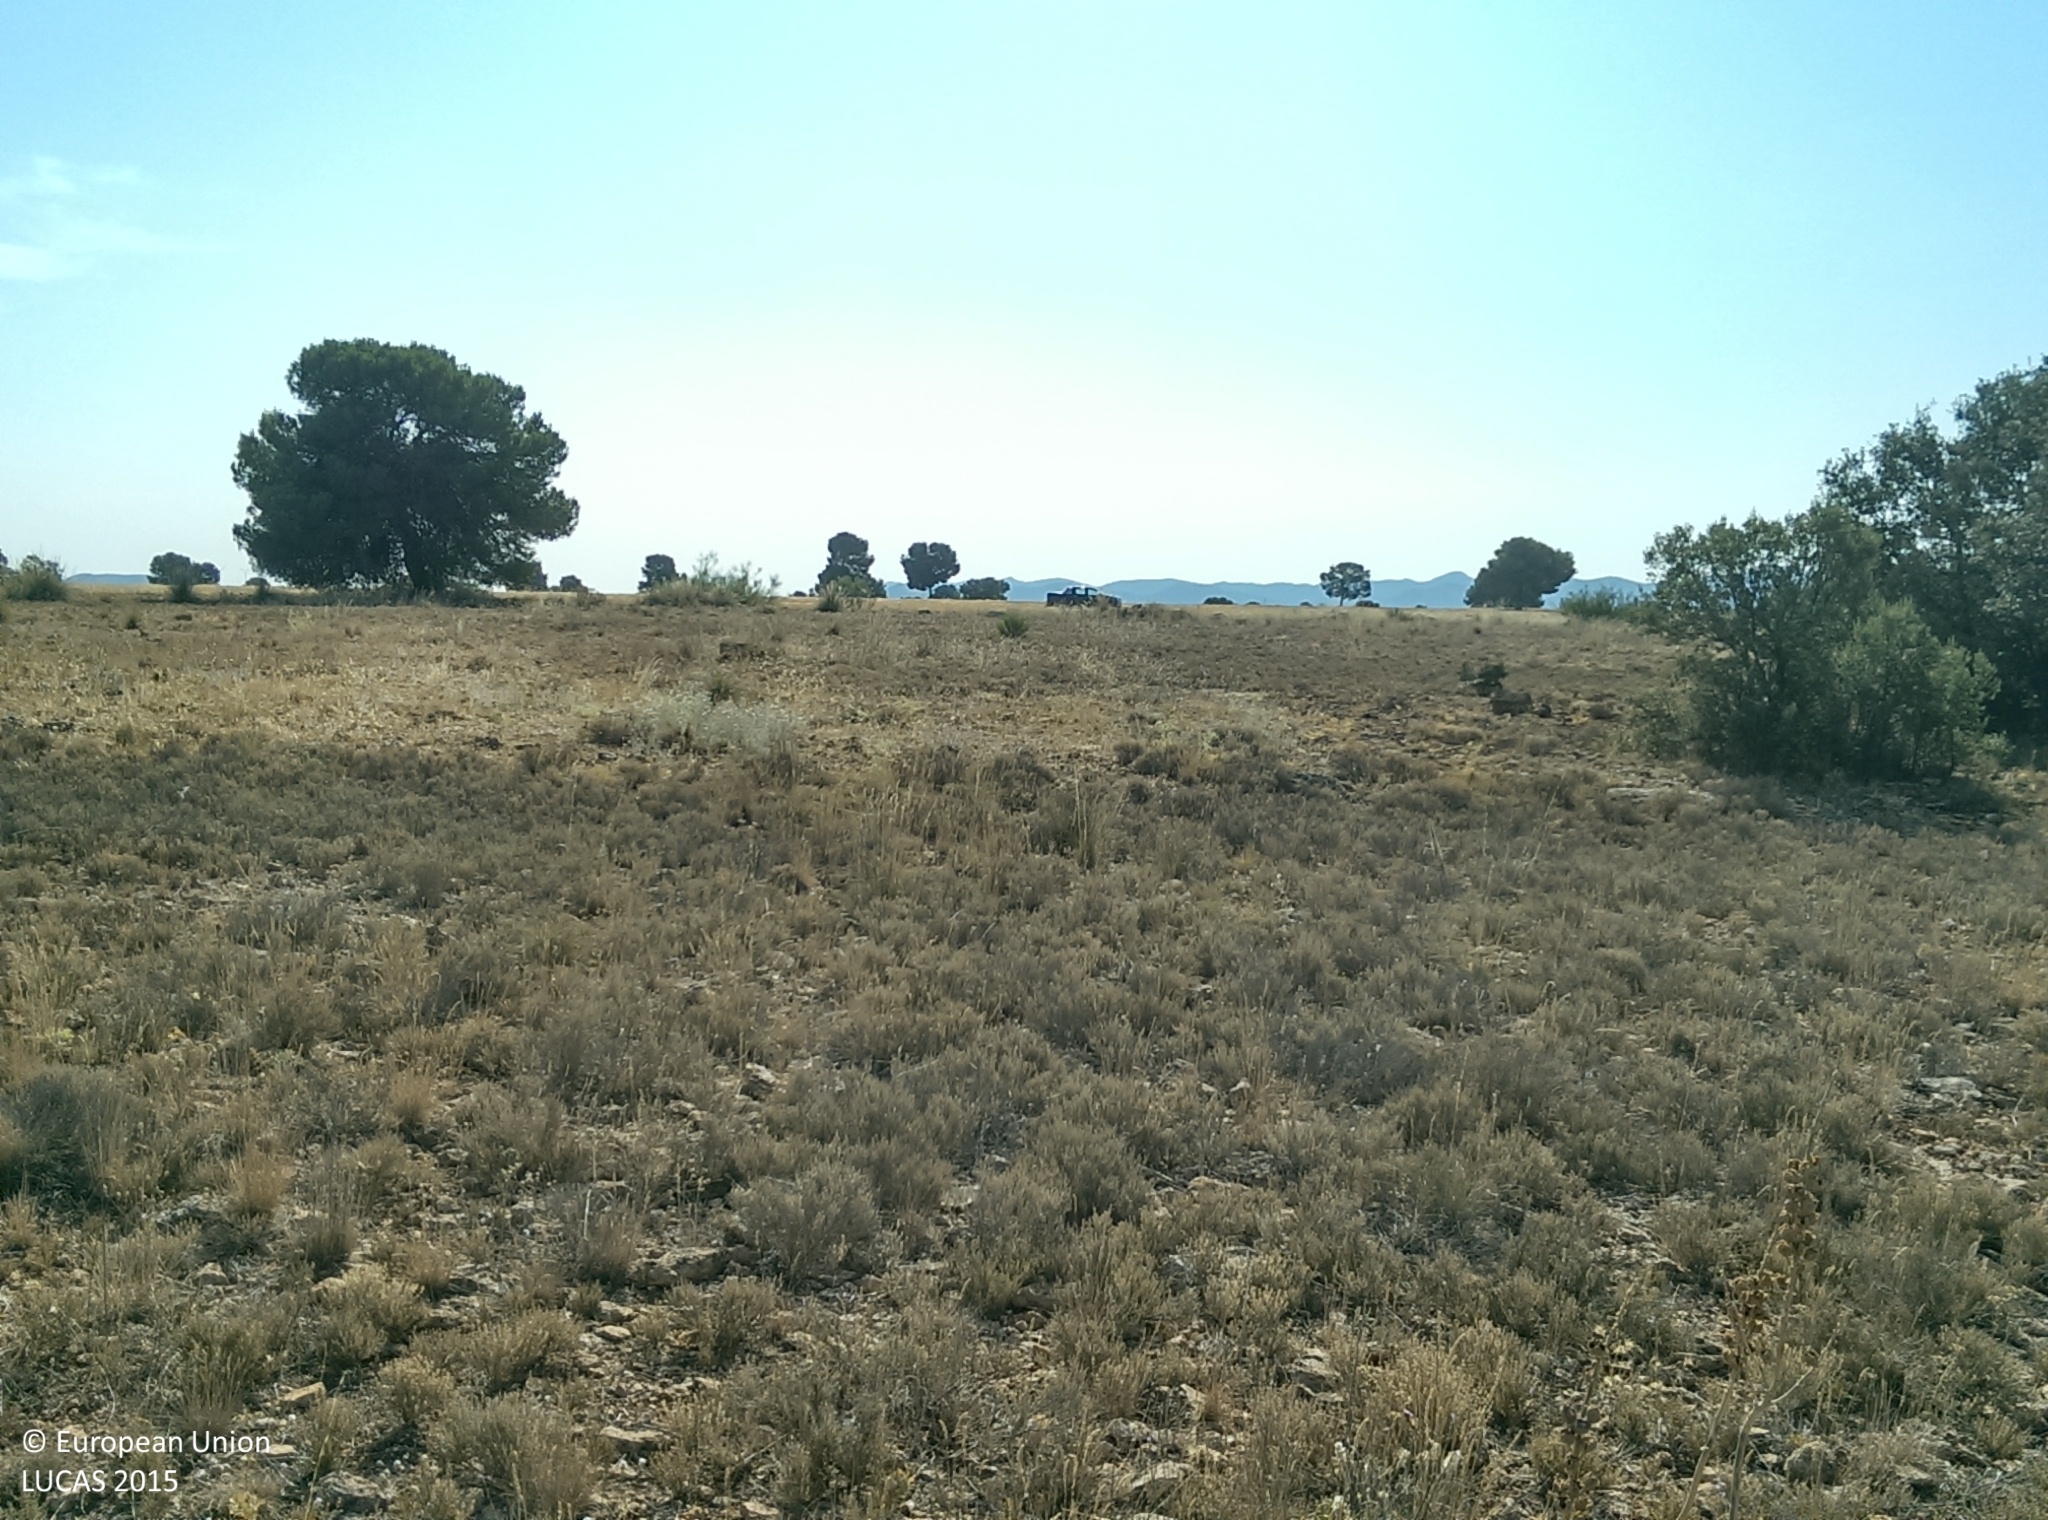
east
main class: Grassland
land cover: Grassland with sparse tree/shrub cover
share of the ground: > 75 %
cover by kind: herbaceous plants 80 %, consolidated bare surface 10 %, broadleaved forest trees 5 %, shrubs 5 %
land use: Semi-natural and natural areas not in use
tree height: < 5 m
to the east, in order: Dry stone walls; Grassland with sparse tree/shrub cover; Grassland without tree/shrub cover; Grass margins; Barley
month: July
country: ES
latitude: 37.4625
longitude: -2.9559
